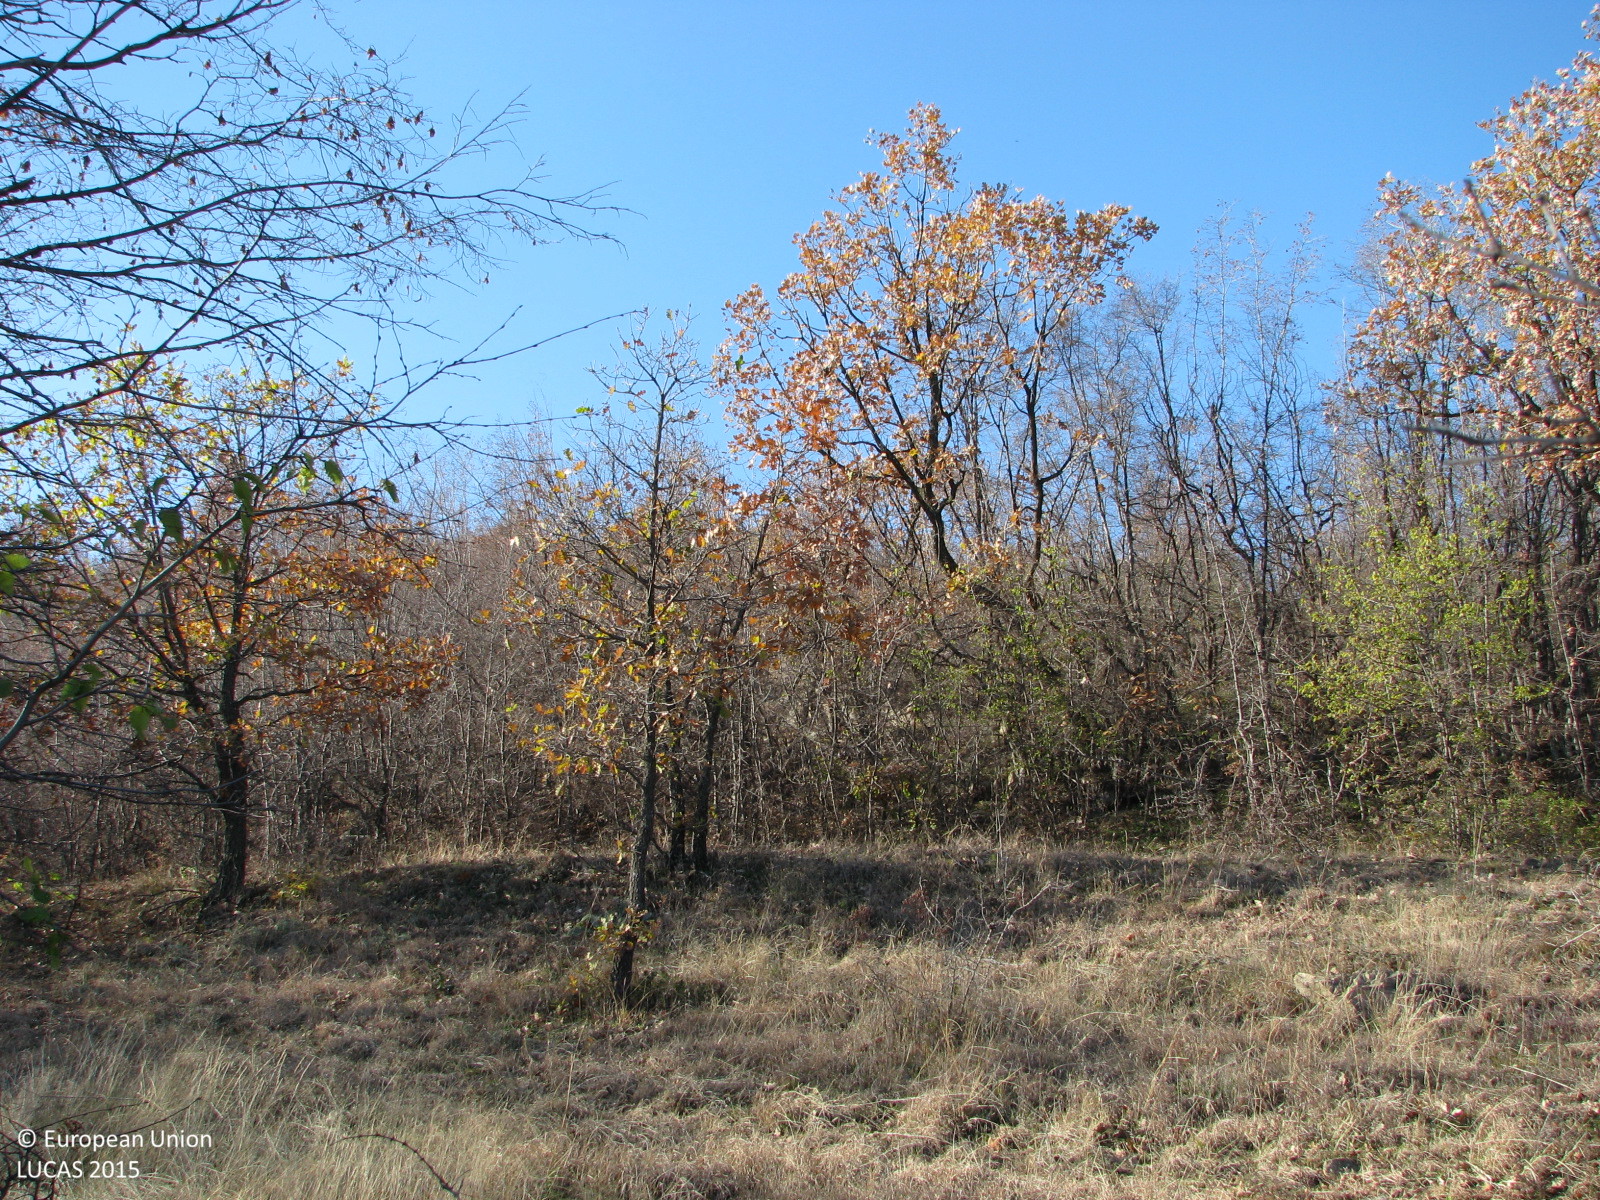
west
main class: Grassland
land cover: Grassland with sparse tree/shrub cover
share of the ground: > 75 %
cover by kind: herbaceous plants 90 %, broadleaved forest trees 5 %, shrubs 5 %
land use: Fallow land
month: December
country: BG
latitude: 42.4354
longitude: 25.0736
